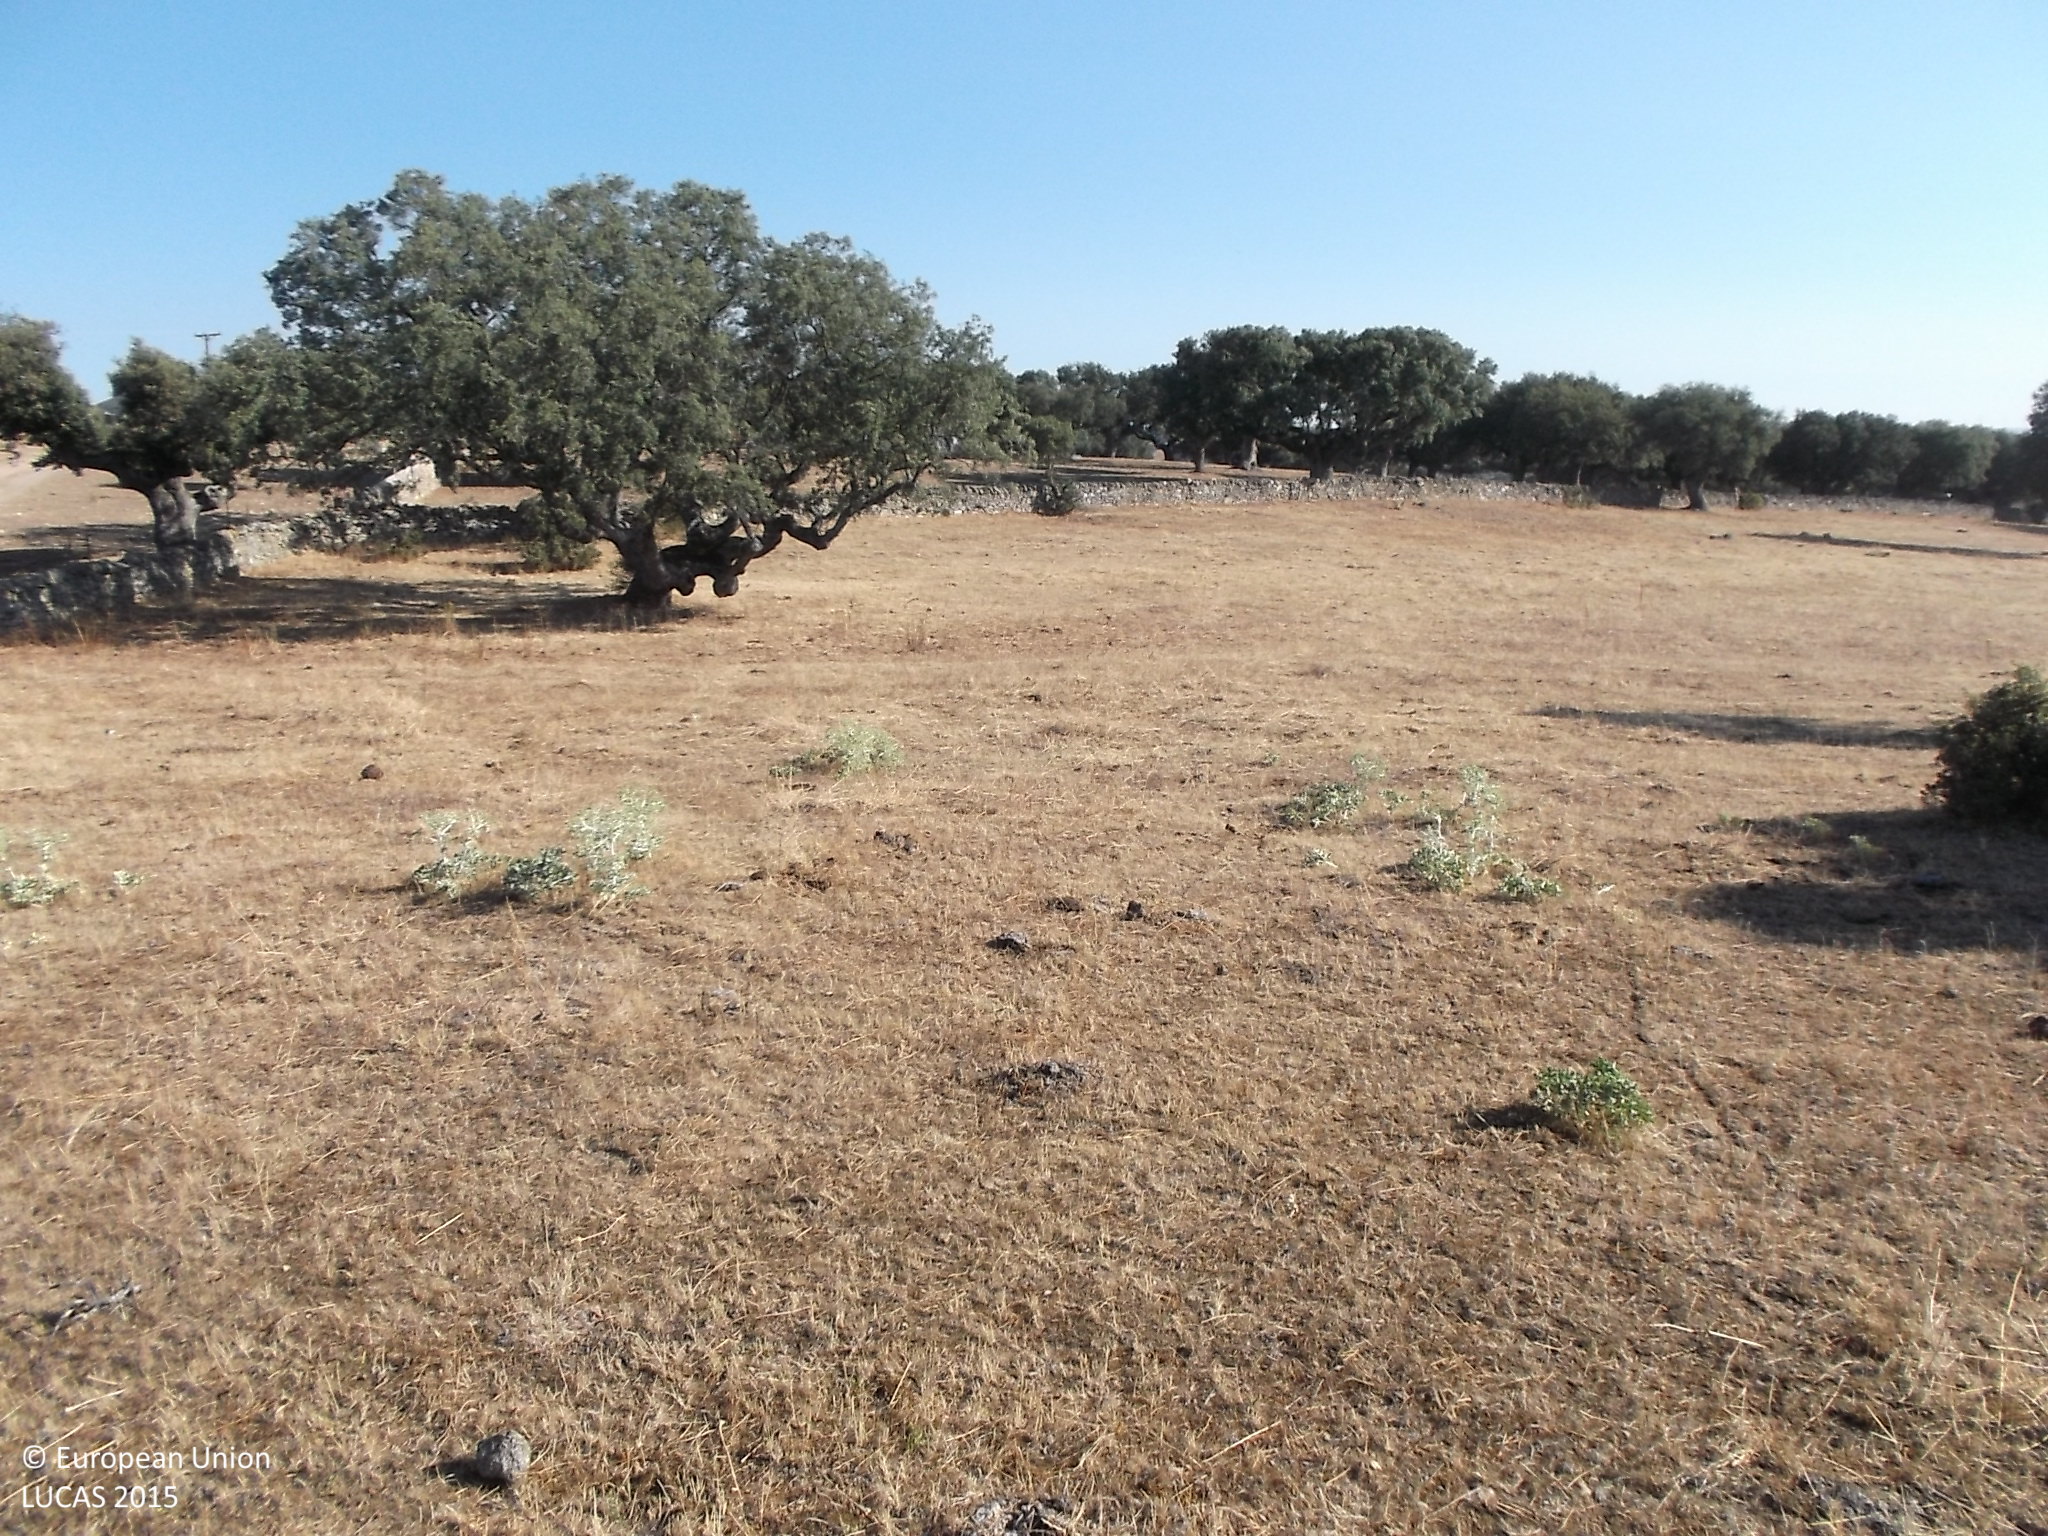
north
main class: Grassland
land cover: Grassland with sparse tree/shrub cover
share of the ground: > 75 %
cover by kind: herbaceous plants 90 %, broadleaved forest trees 5 %, shrubs 5 %
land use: Agriculture (excluding fallow land and kitchen gardens)
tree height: < 5 m
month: July
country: ES
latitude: 41.1037
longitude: -5.9574
